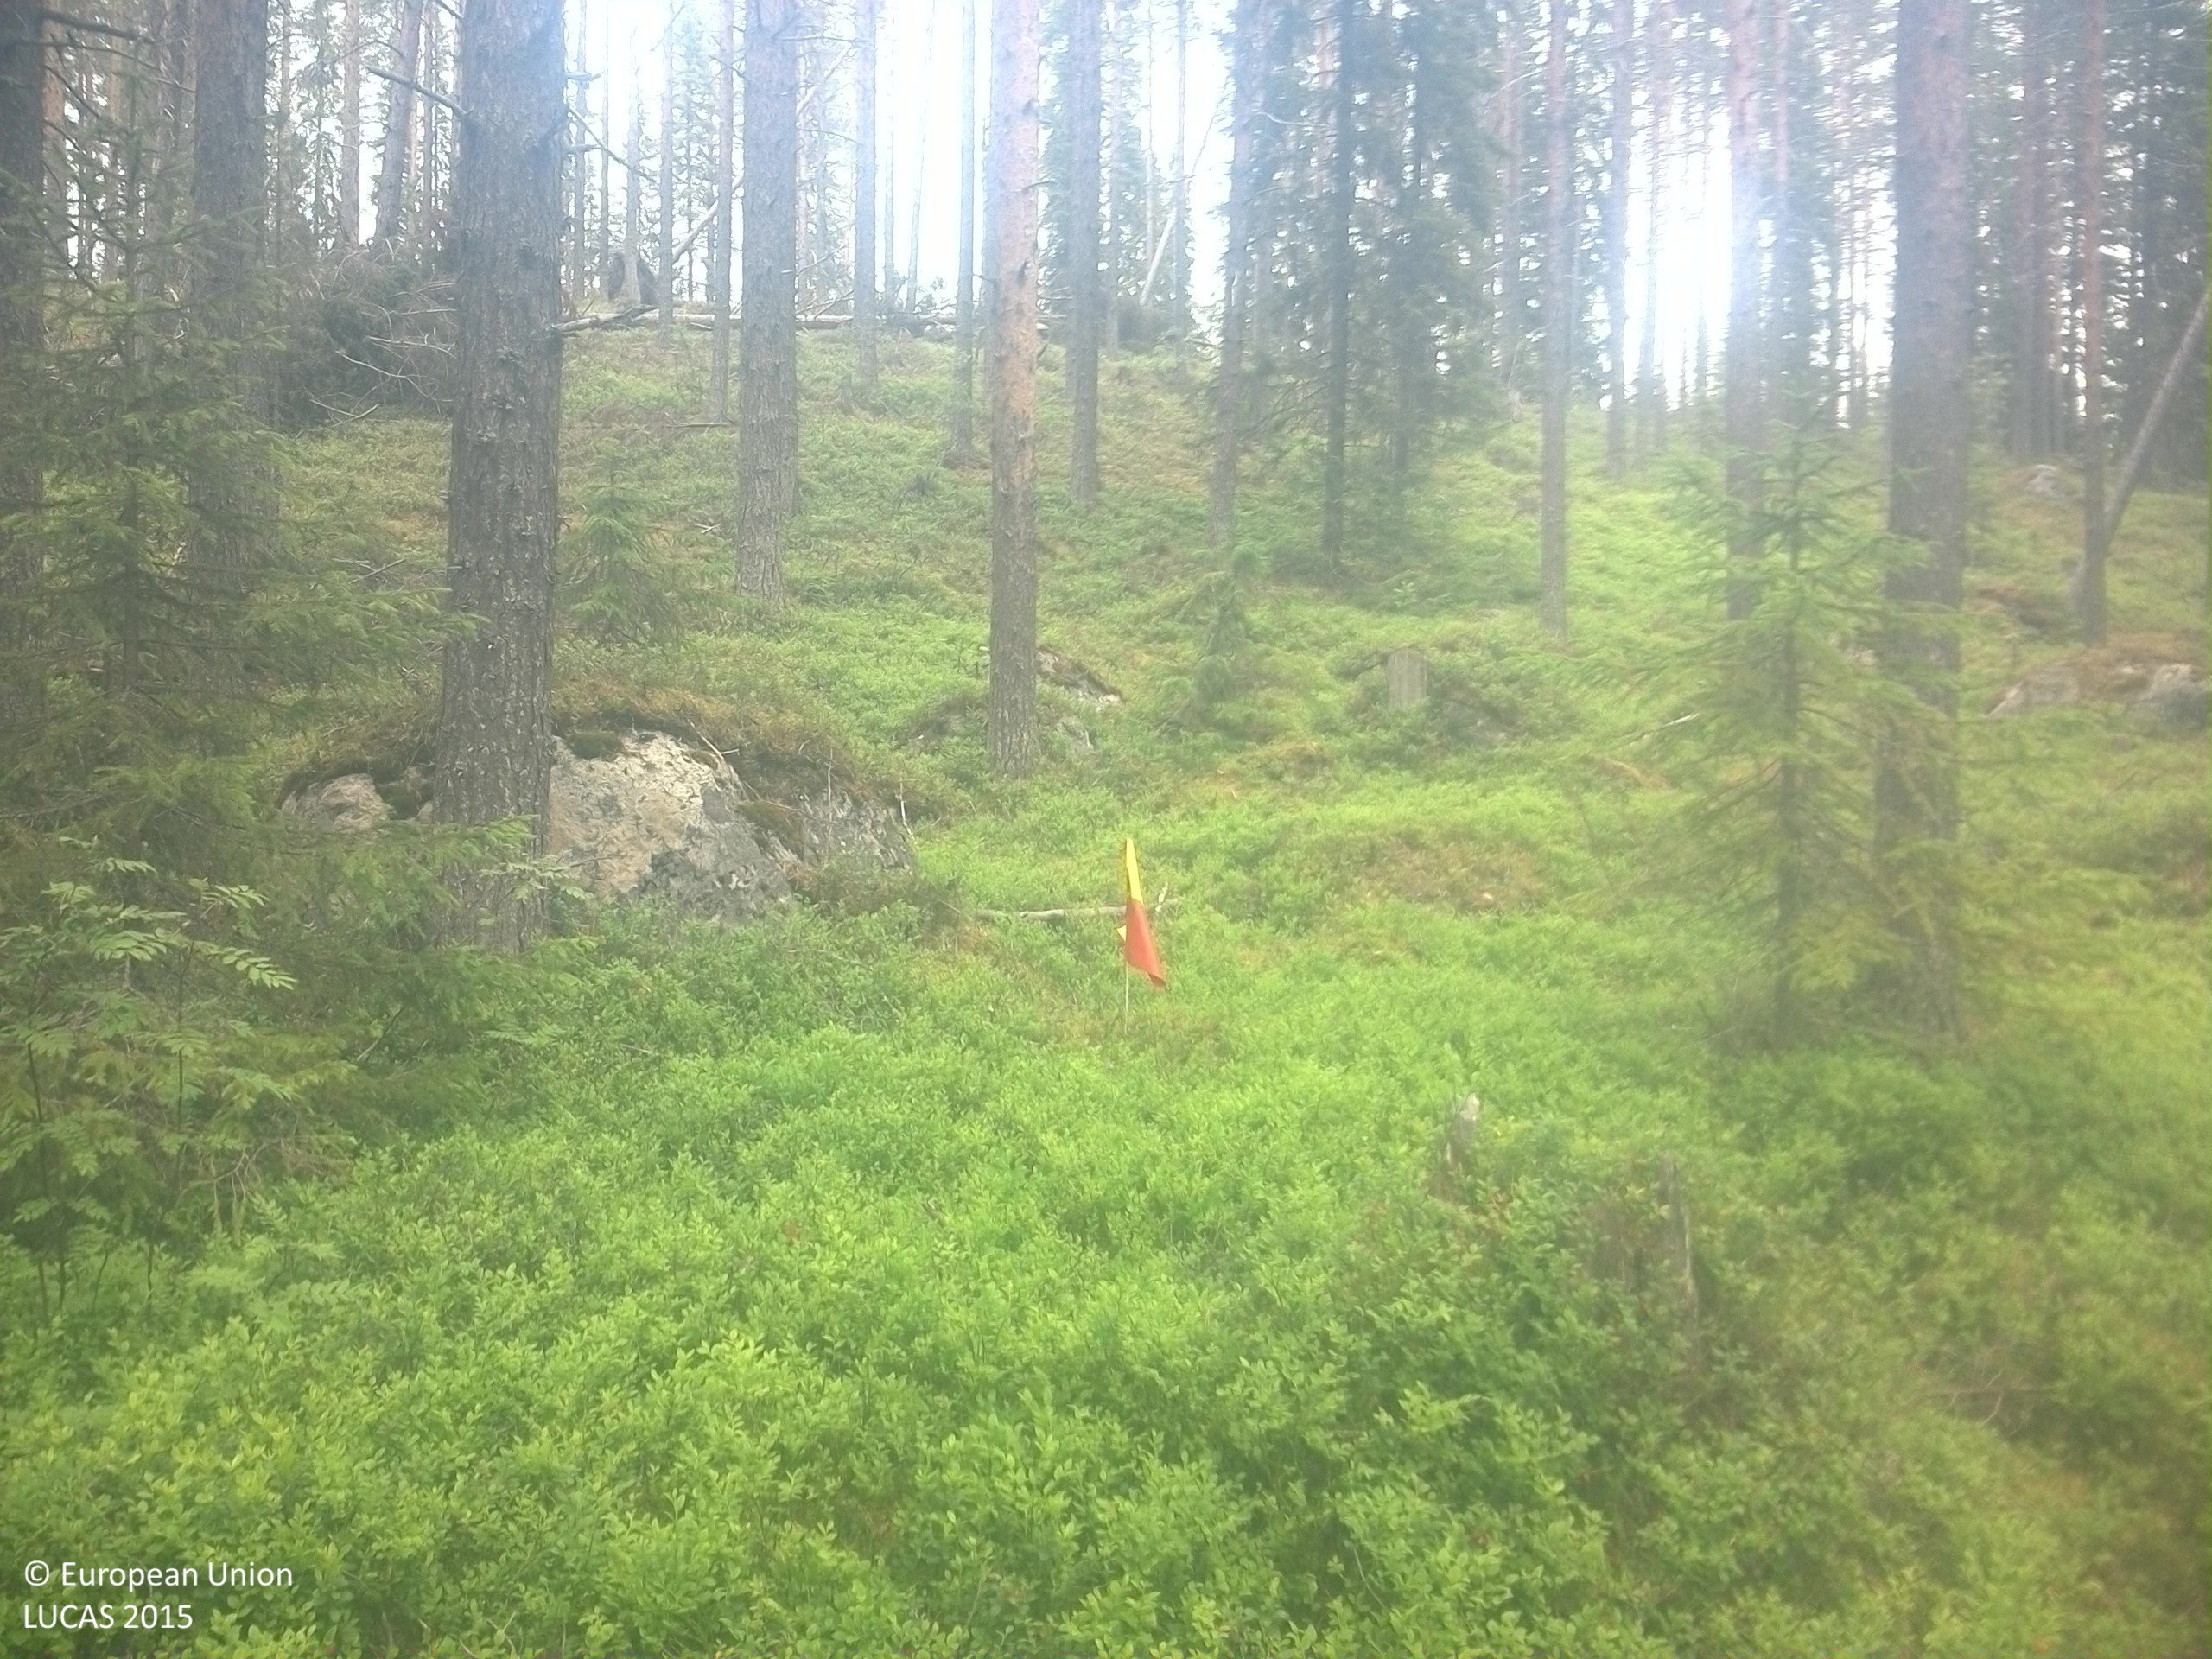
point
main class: Woodland
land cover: Pine dominated coniferous woodland
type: boreal forest
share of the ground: 25 - 50 %
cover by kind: shrubs 45 %, coniferous forest trees 40 %, lichens and mosses 10 %, consolidated bare surface 5 %
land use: Forestry
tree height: > 5 m
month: July
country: SE
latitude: 64.2021
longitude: 16.7039
